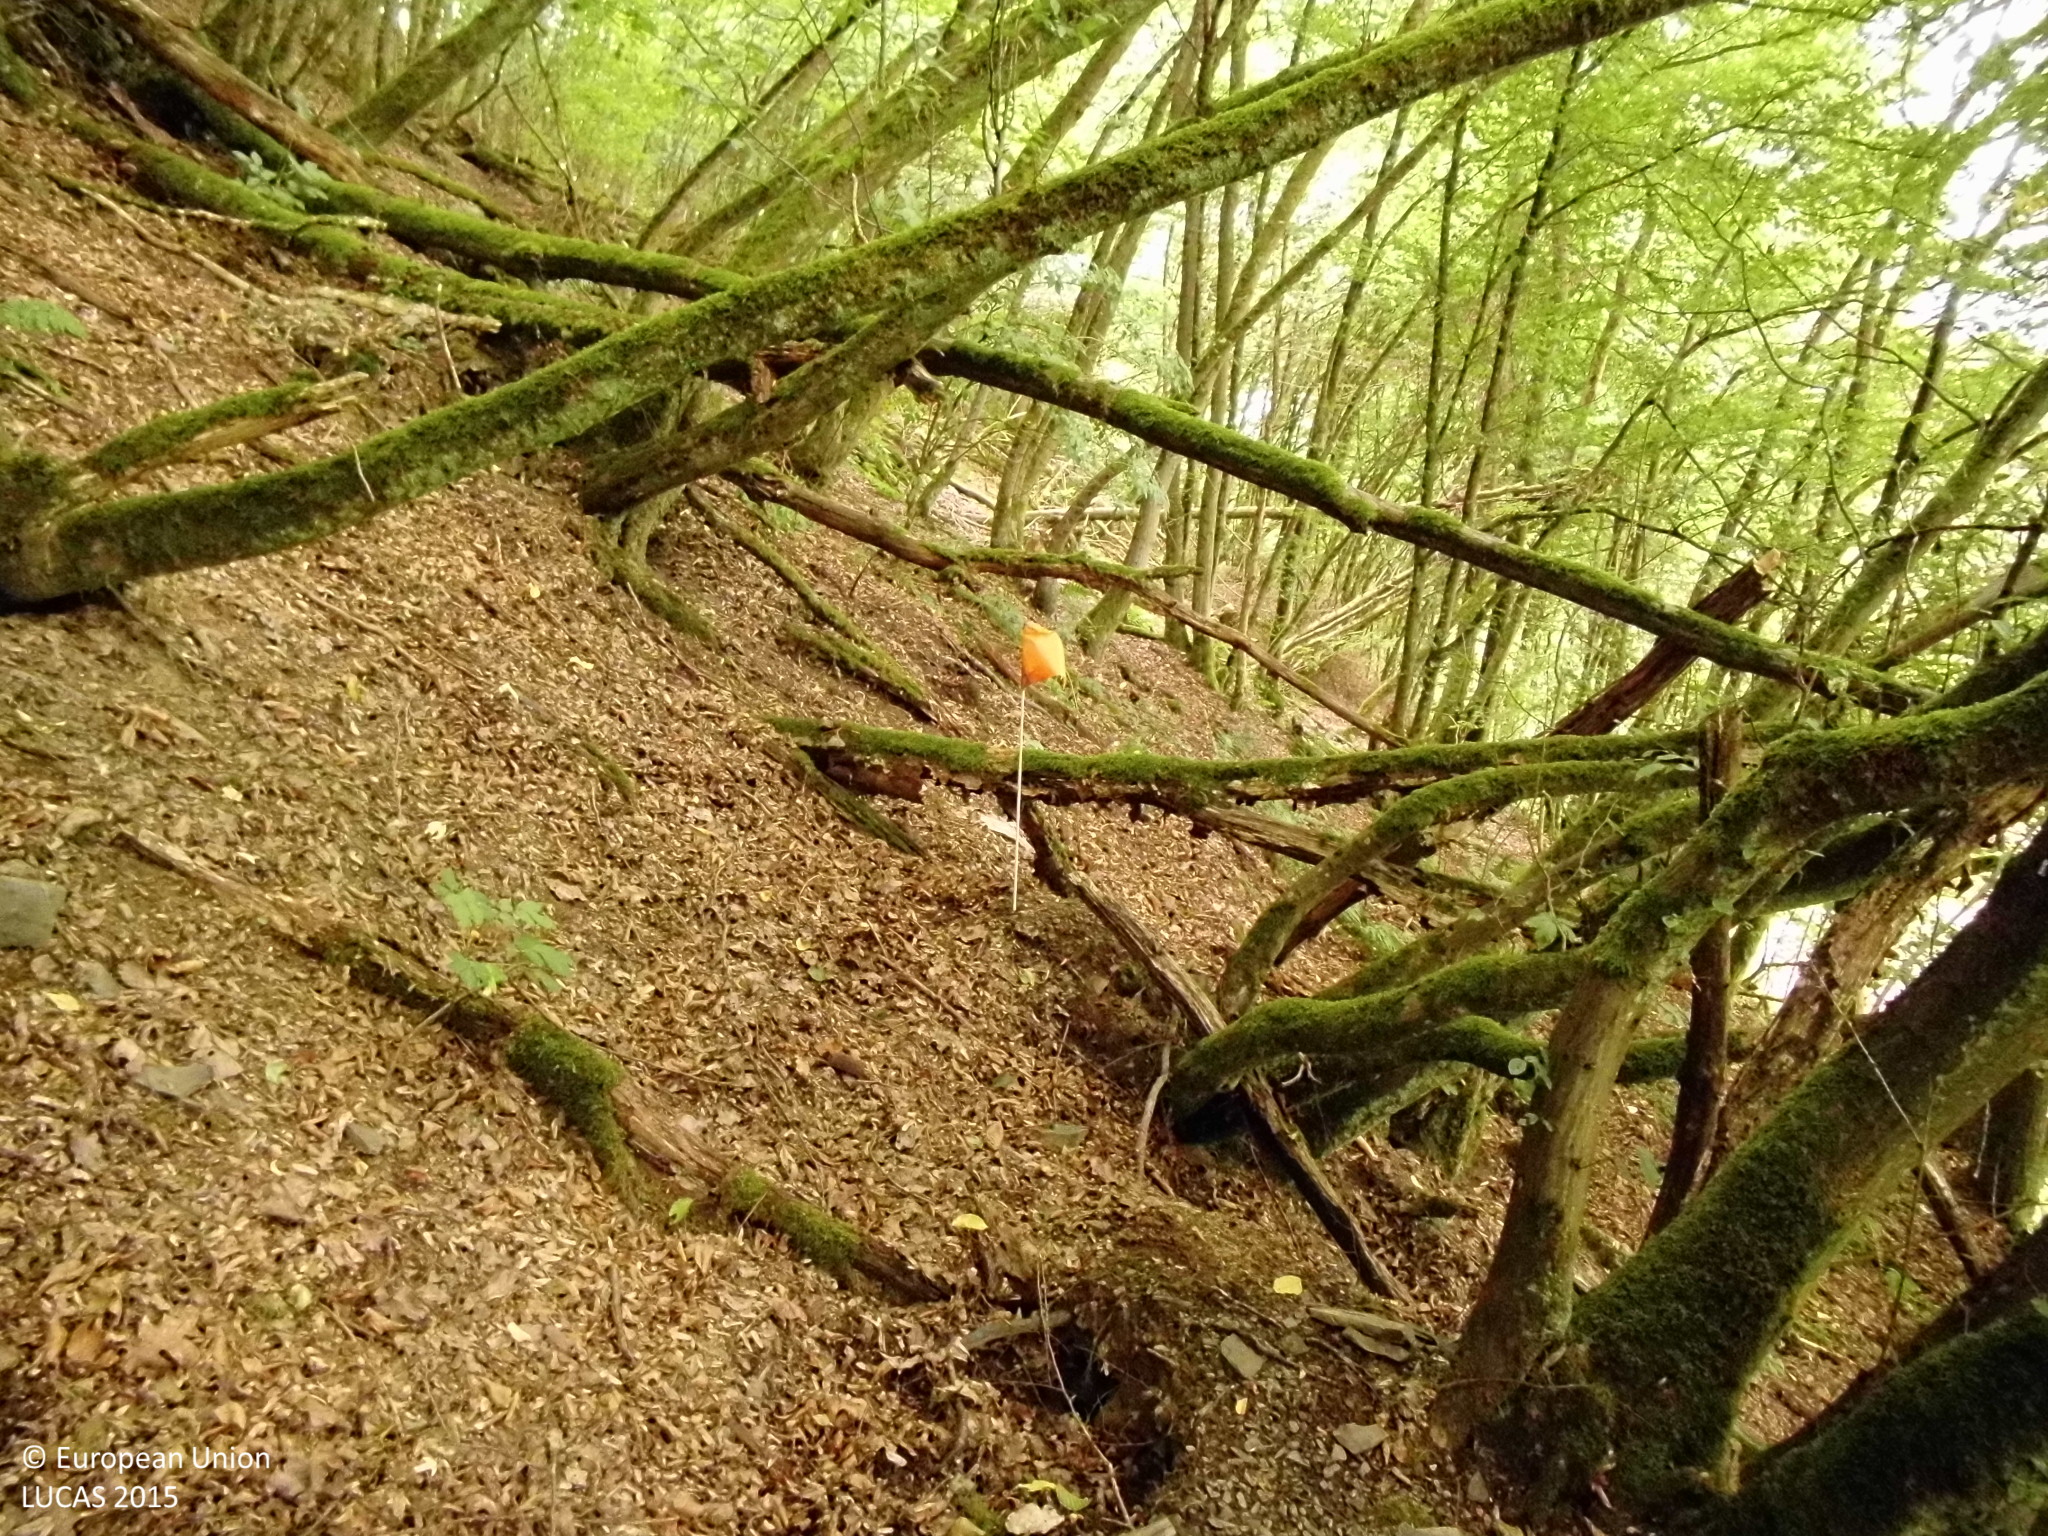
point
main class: Woodland
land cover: Broadleaved woodland
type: mesophytic deciduous forest
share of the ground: > 75 %
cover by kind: broadleaved forest trees 100 %
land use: Forestry
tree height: > 5 m
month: August
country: DE
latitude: 51.0207
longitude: 8.5890
